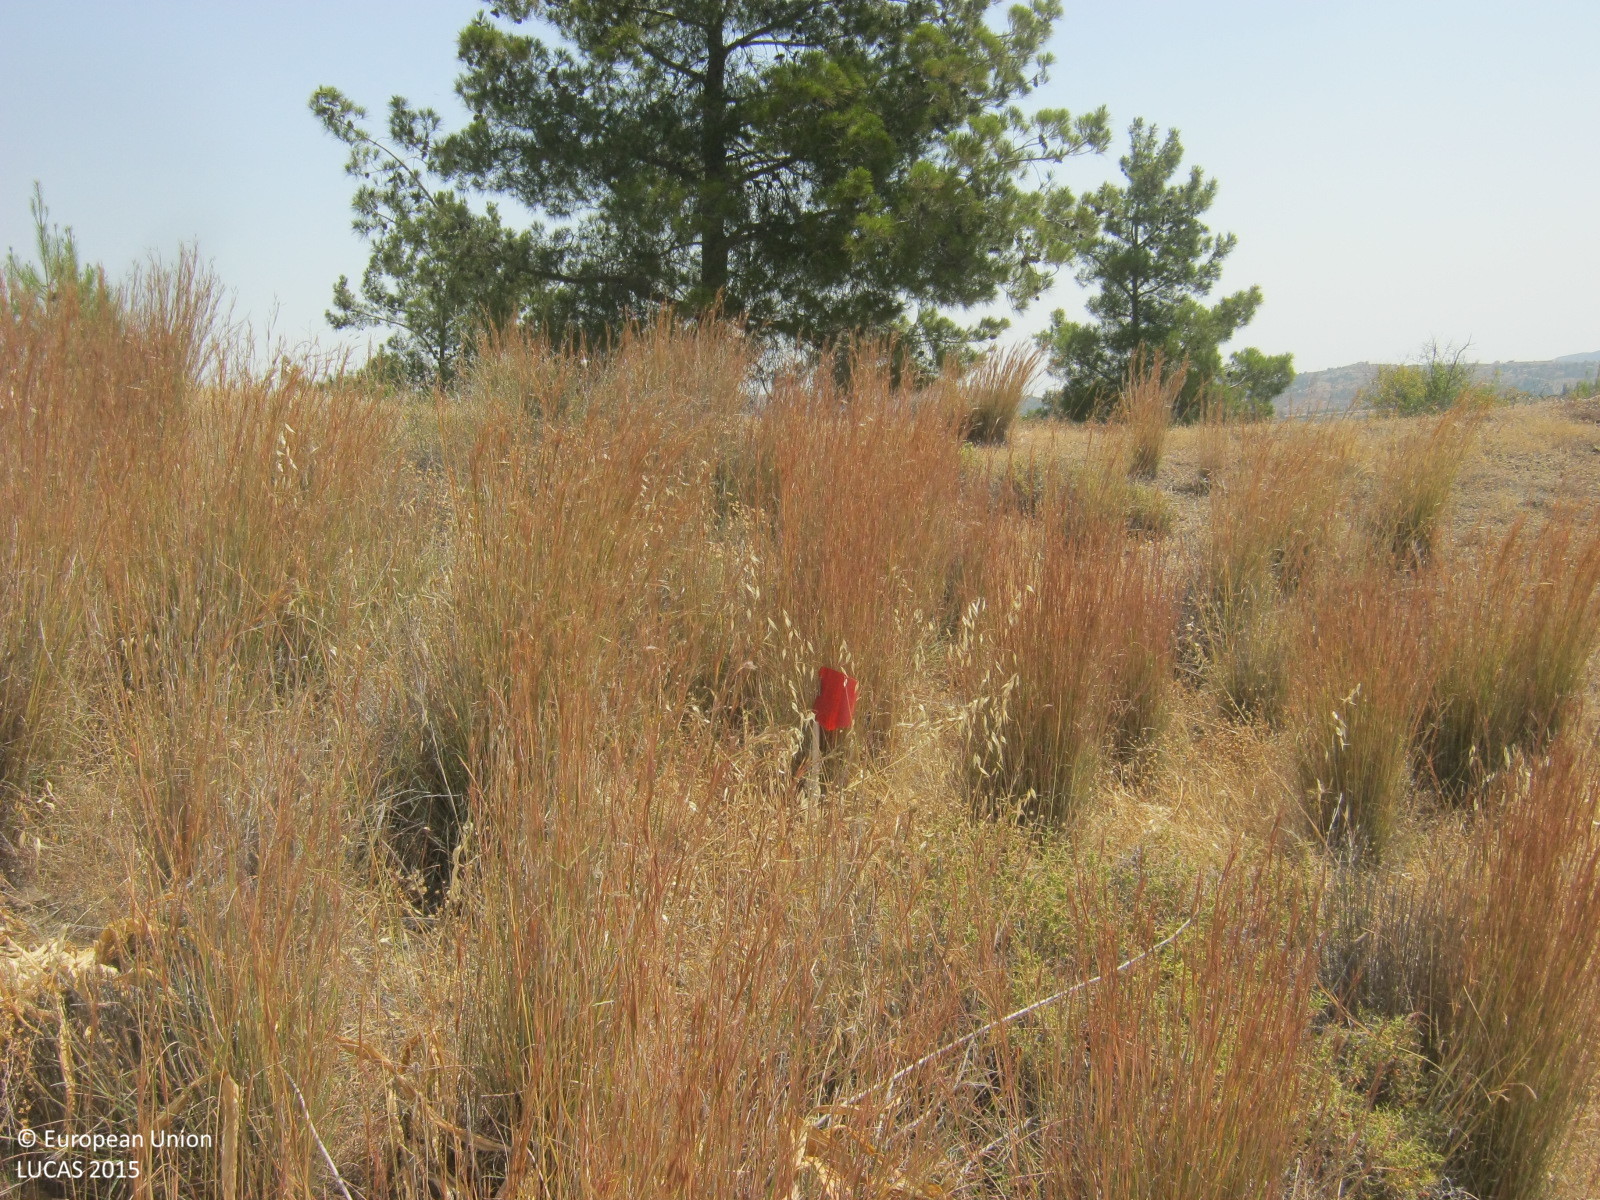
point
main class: Shrubland
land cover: Shrubland without tree cover
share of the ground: 10 - 25 %
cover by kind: herbaceous plants 70 %, shrubs 25 %, unconsolidated bare surface 5 %
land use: Semi-natural and natural areas not in use
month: June
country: CY
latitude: 35.0357
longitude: 33.0082
